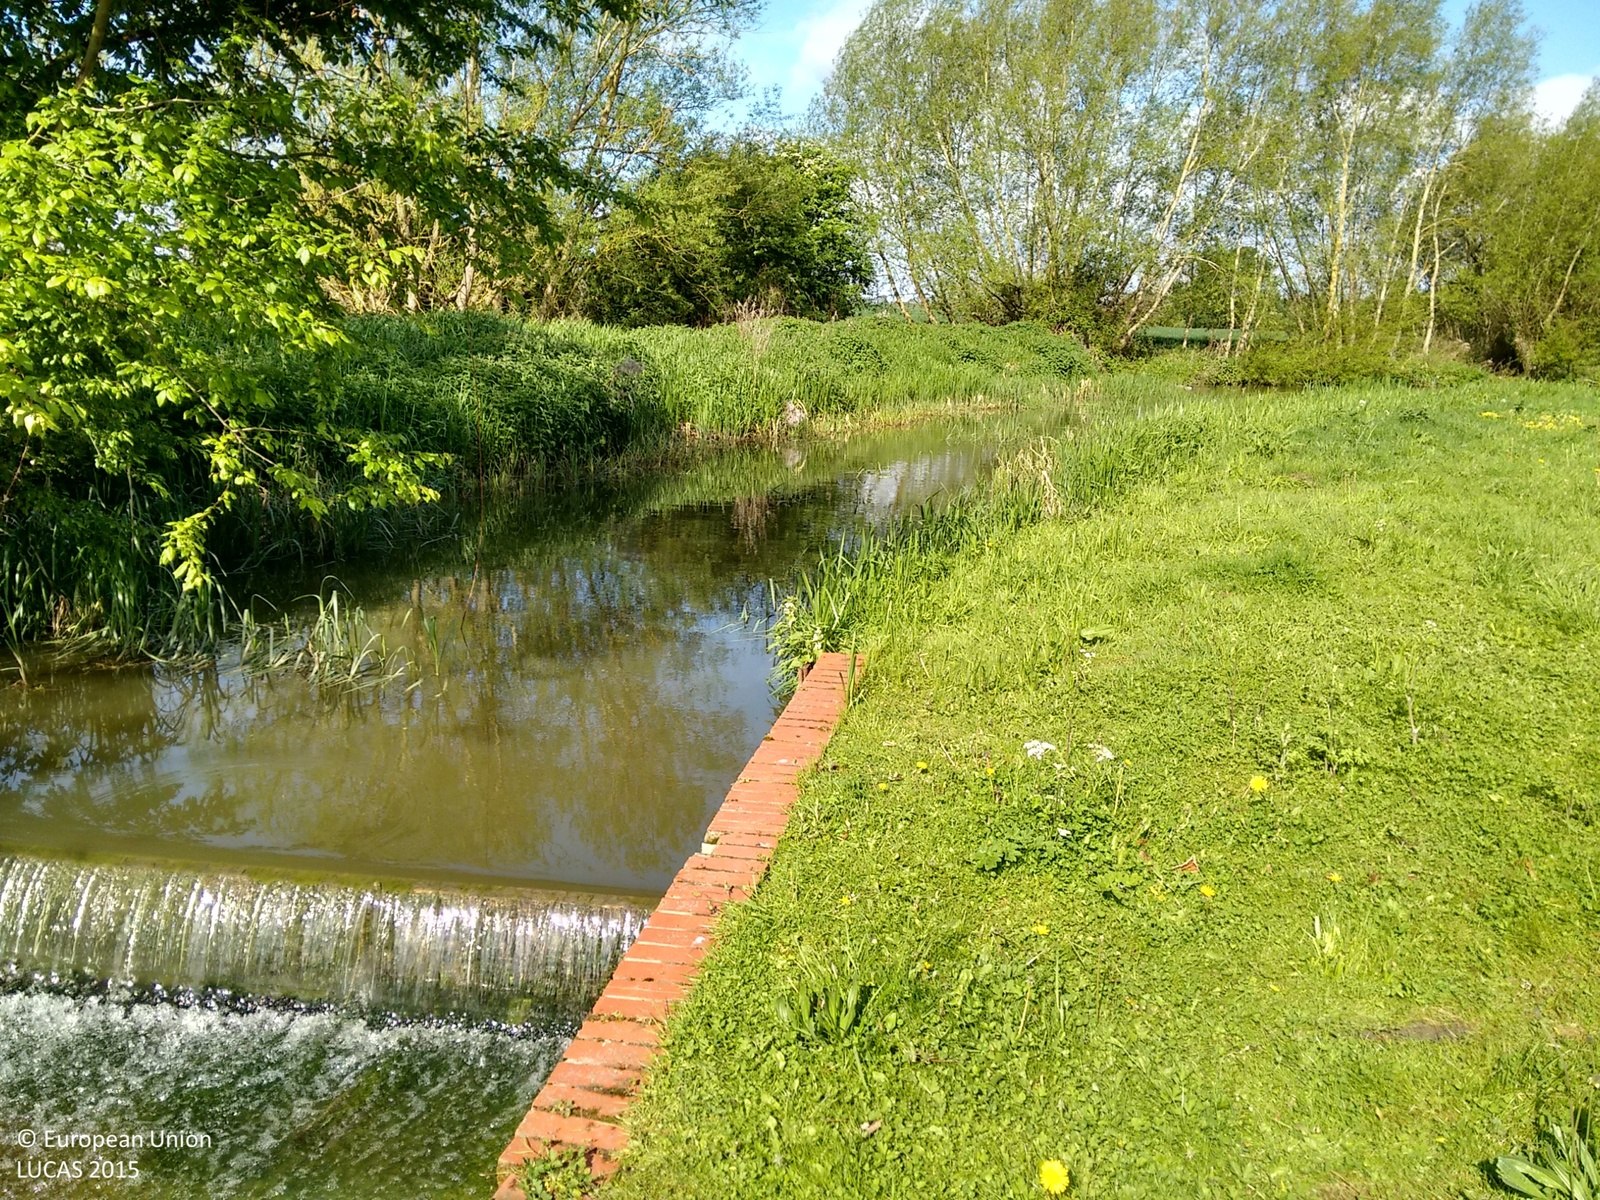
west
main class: Woodland
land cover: Broadleaved woodland
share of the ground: > 75 %
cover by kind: broadleaved forest trees 80 %, shrubs 10 %, herbaceous plants 10 %
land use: Semi-natural and natural areas not in use
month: May
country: GB
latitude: 52.2098
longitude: -1.7475
